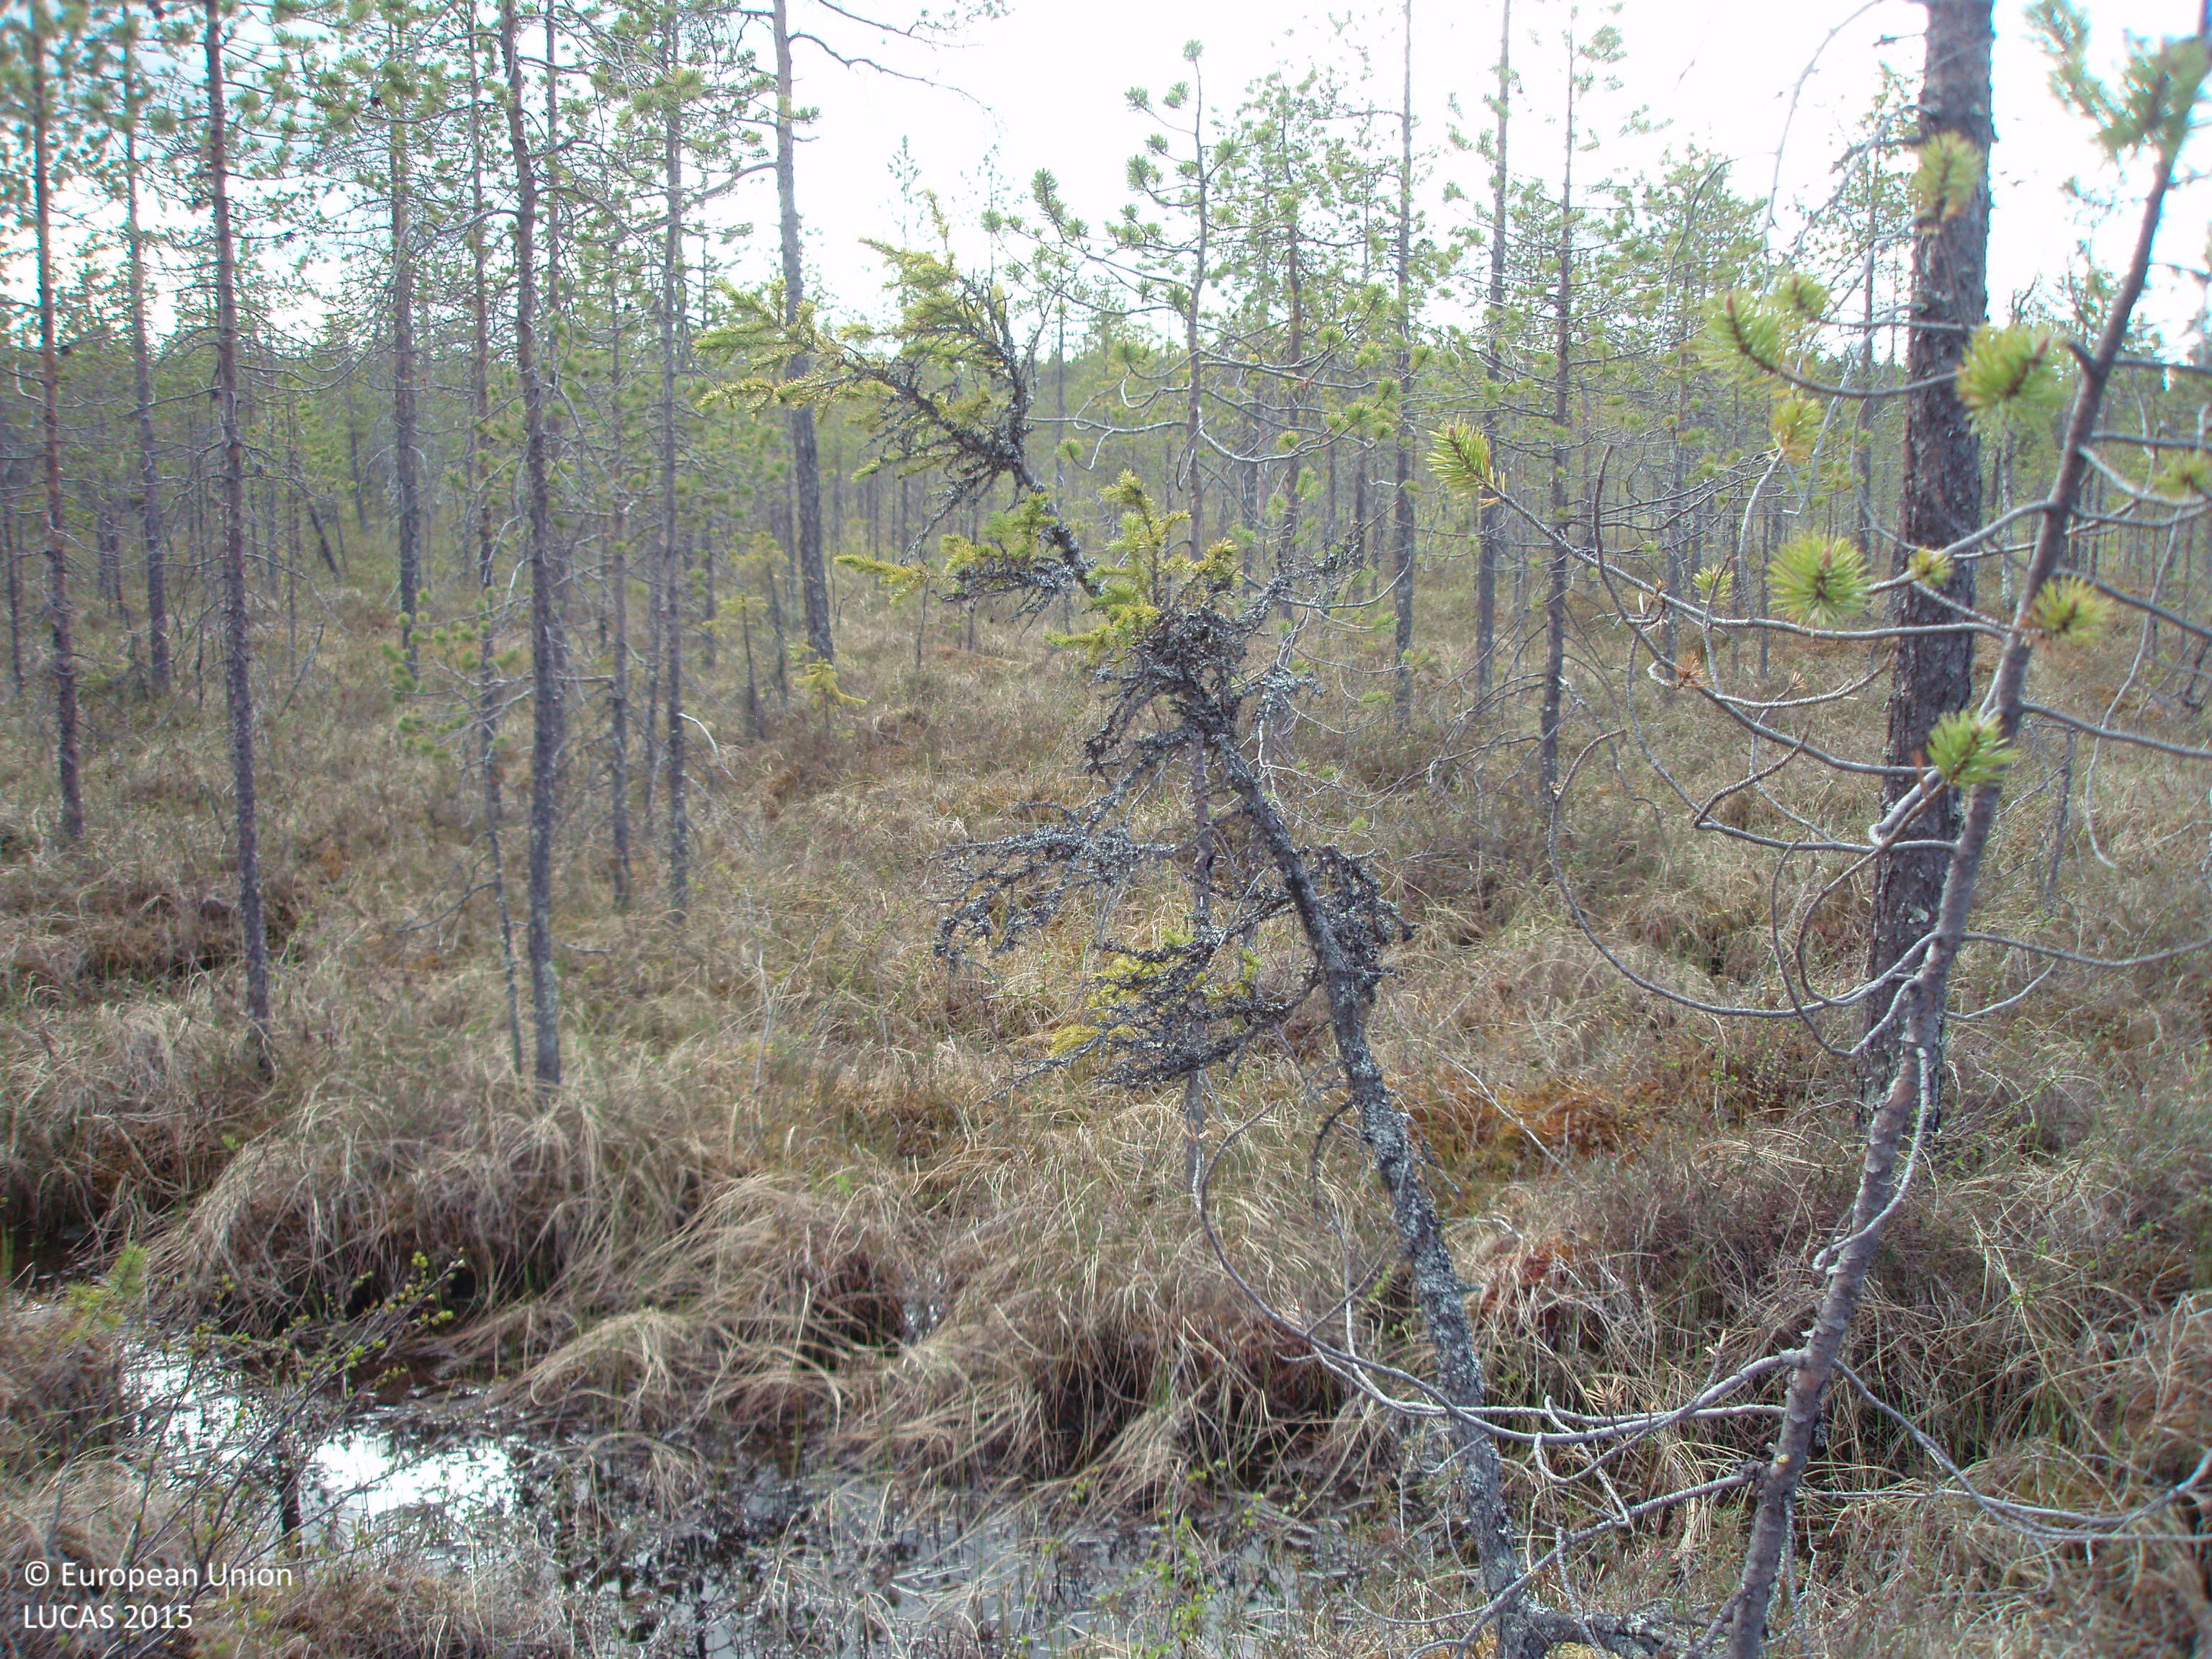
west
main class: Woodland
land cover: Pine dominated coniferous woodland
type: mire and swamp forests
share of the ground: 25 - 50 %
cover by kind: coniferous forest trees 40 %, shrubs 30 %, herbaceous plants 30 %
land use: Semi-natural and natural areas not in use
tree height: > 5 m
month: June
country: FI
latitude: 66.9800
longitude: 27.0752
